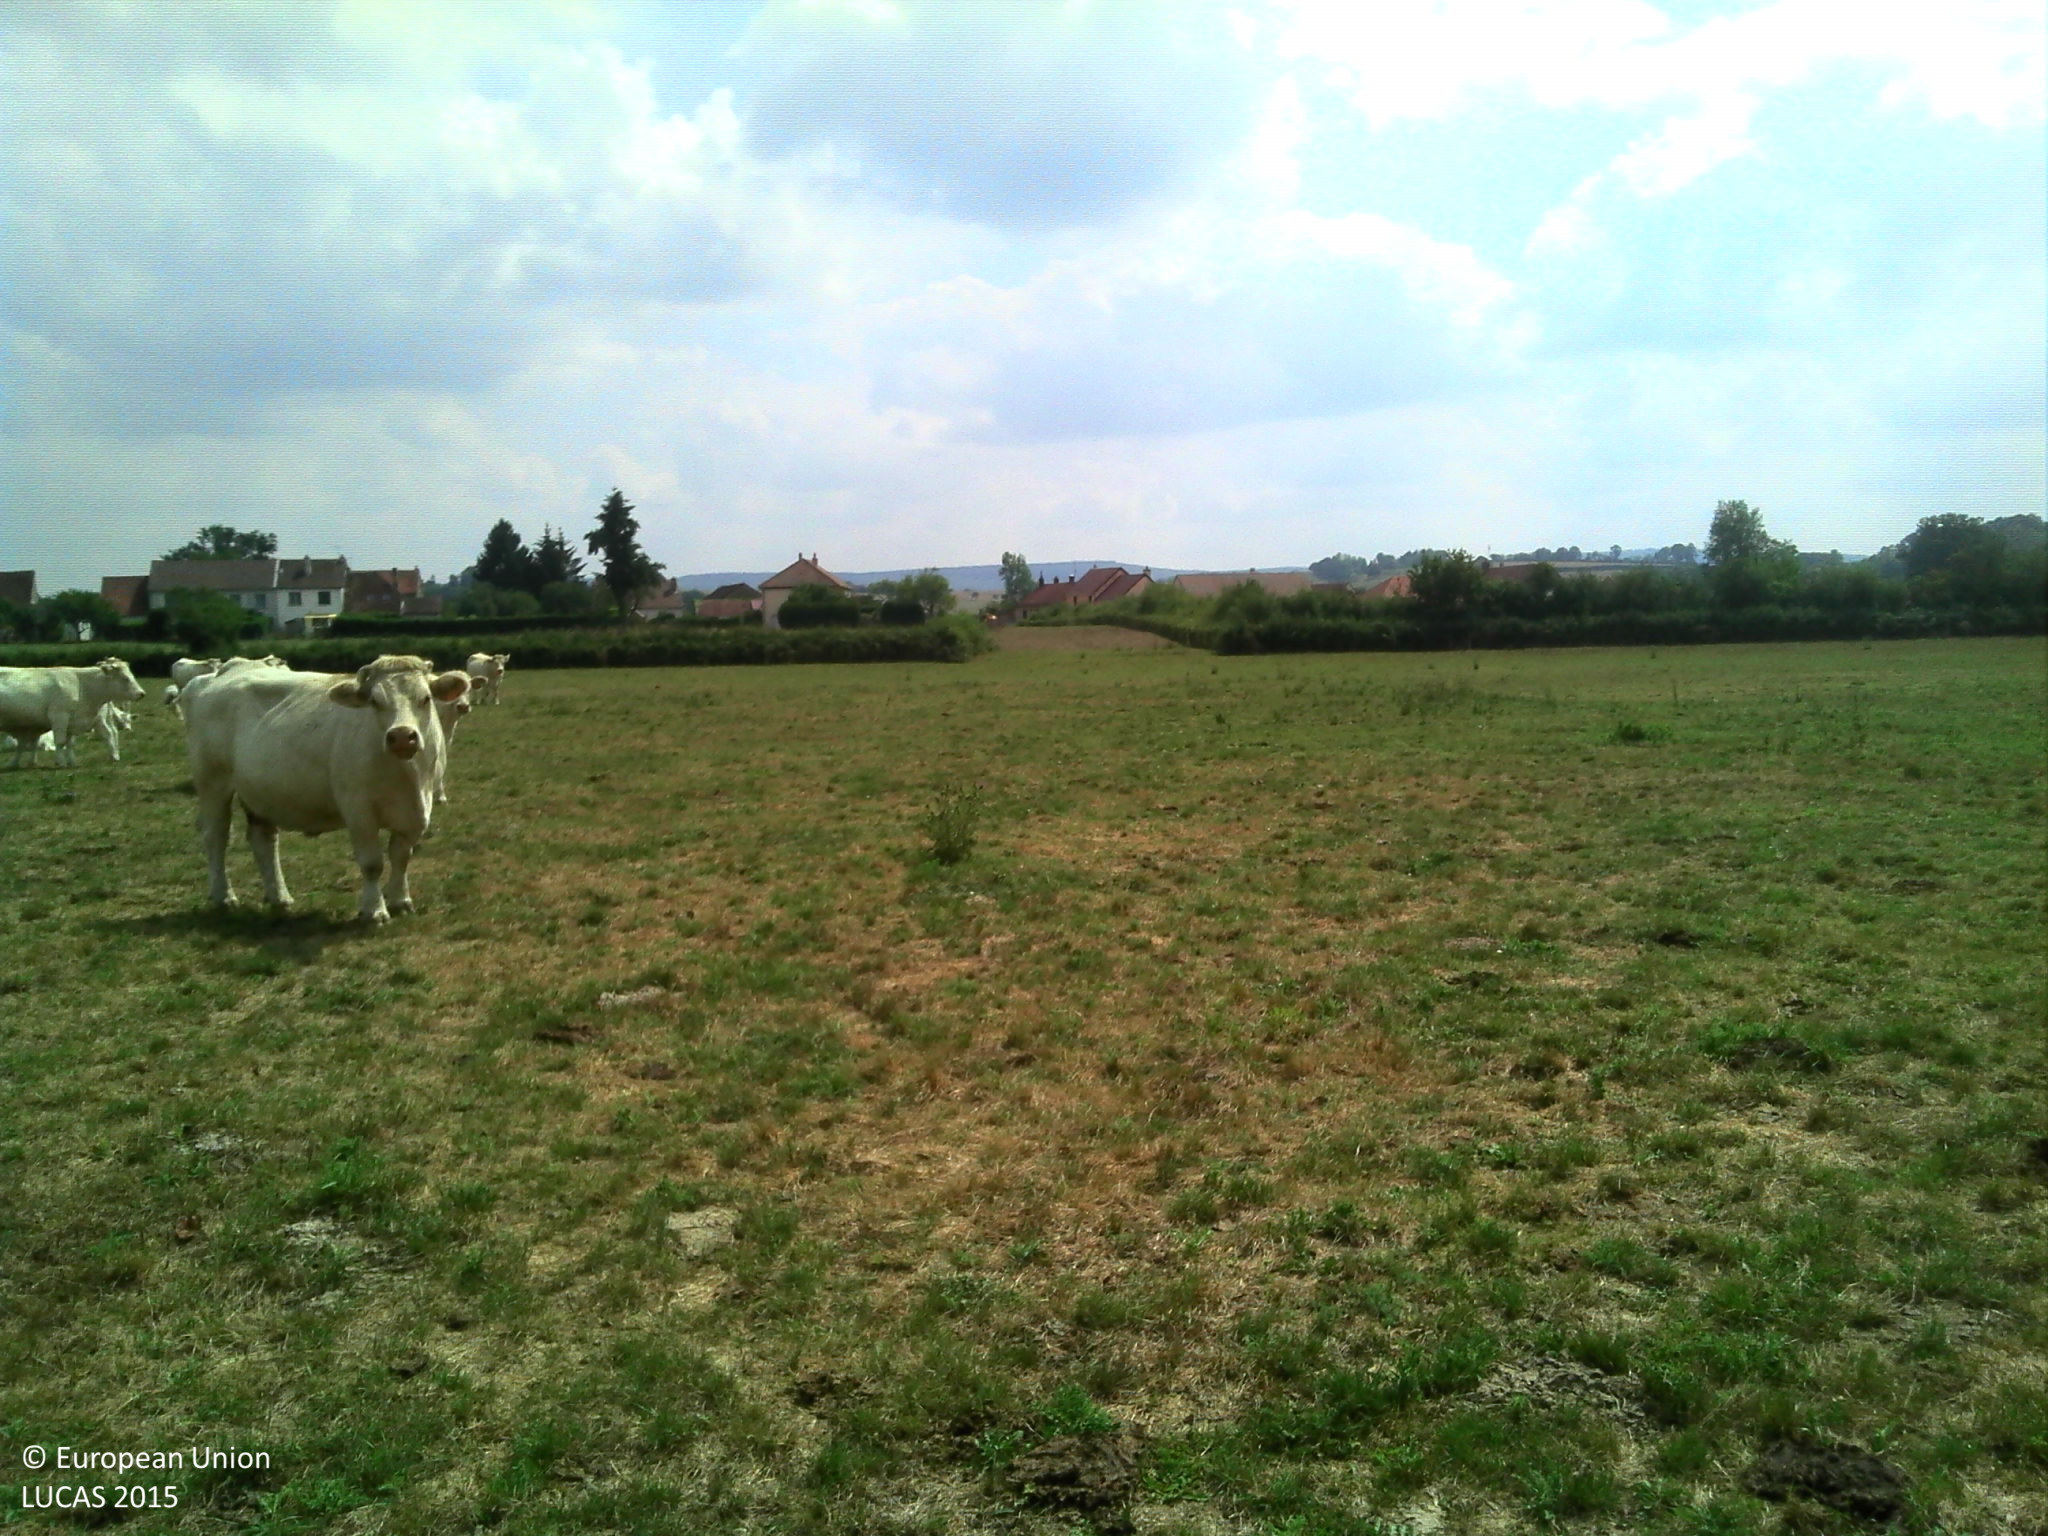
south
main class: Grassland
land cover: Grassland without tree/shrub cover
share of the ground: > 75 %
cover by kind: herbaceous plants 100 %
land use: Agriculture (excluding fallow land and kitchen gardens)
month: August
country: FR
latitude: 47.0131
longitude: 4.3302
